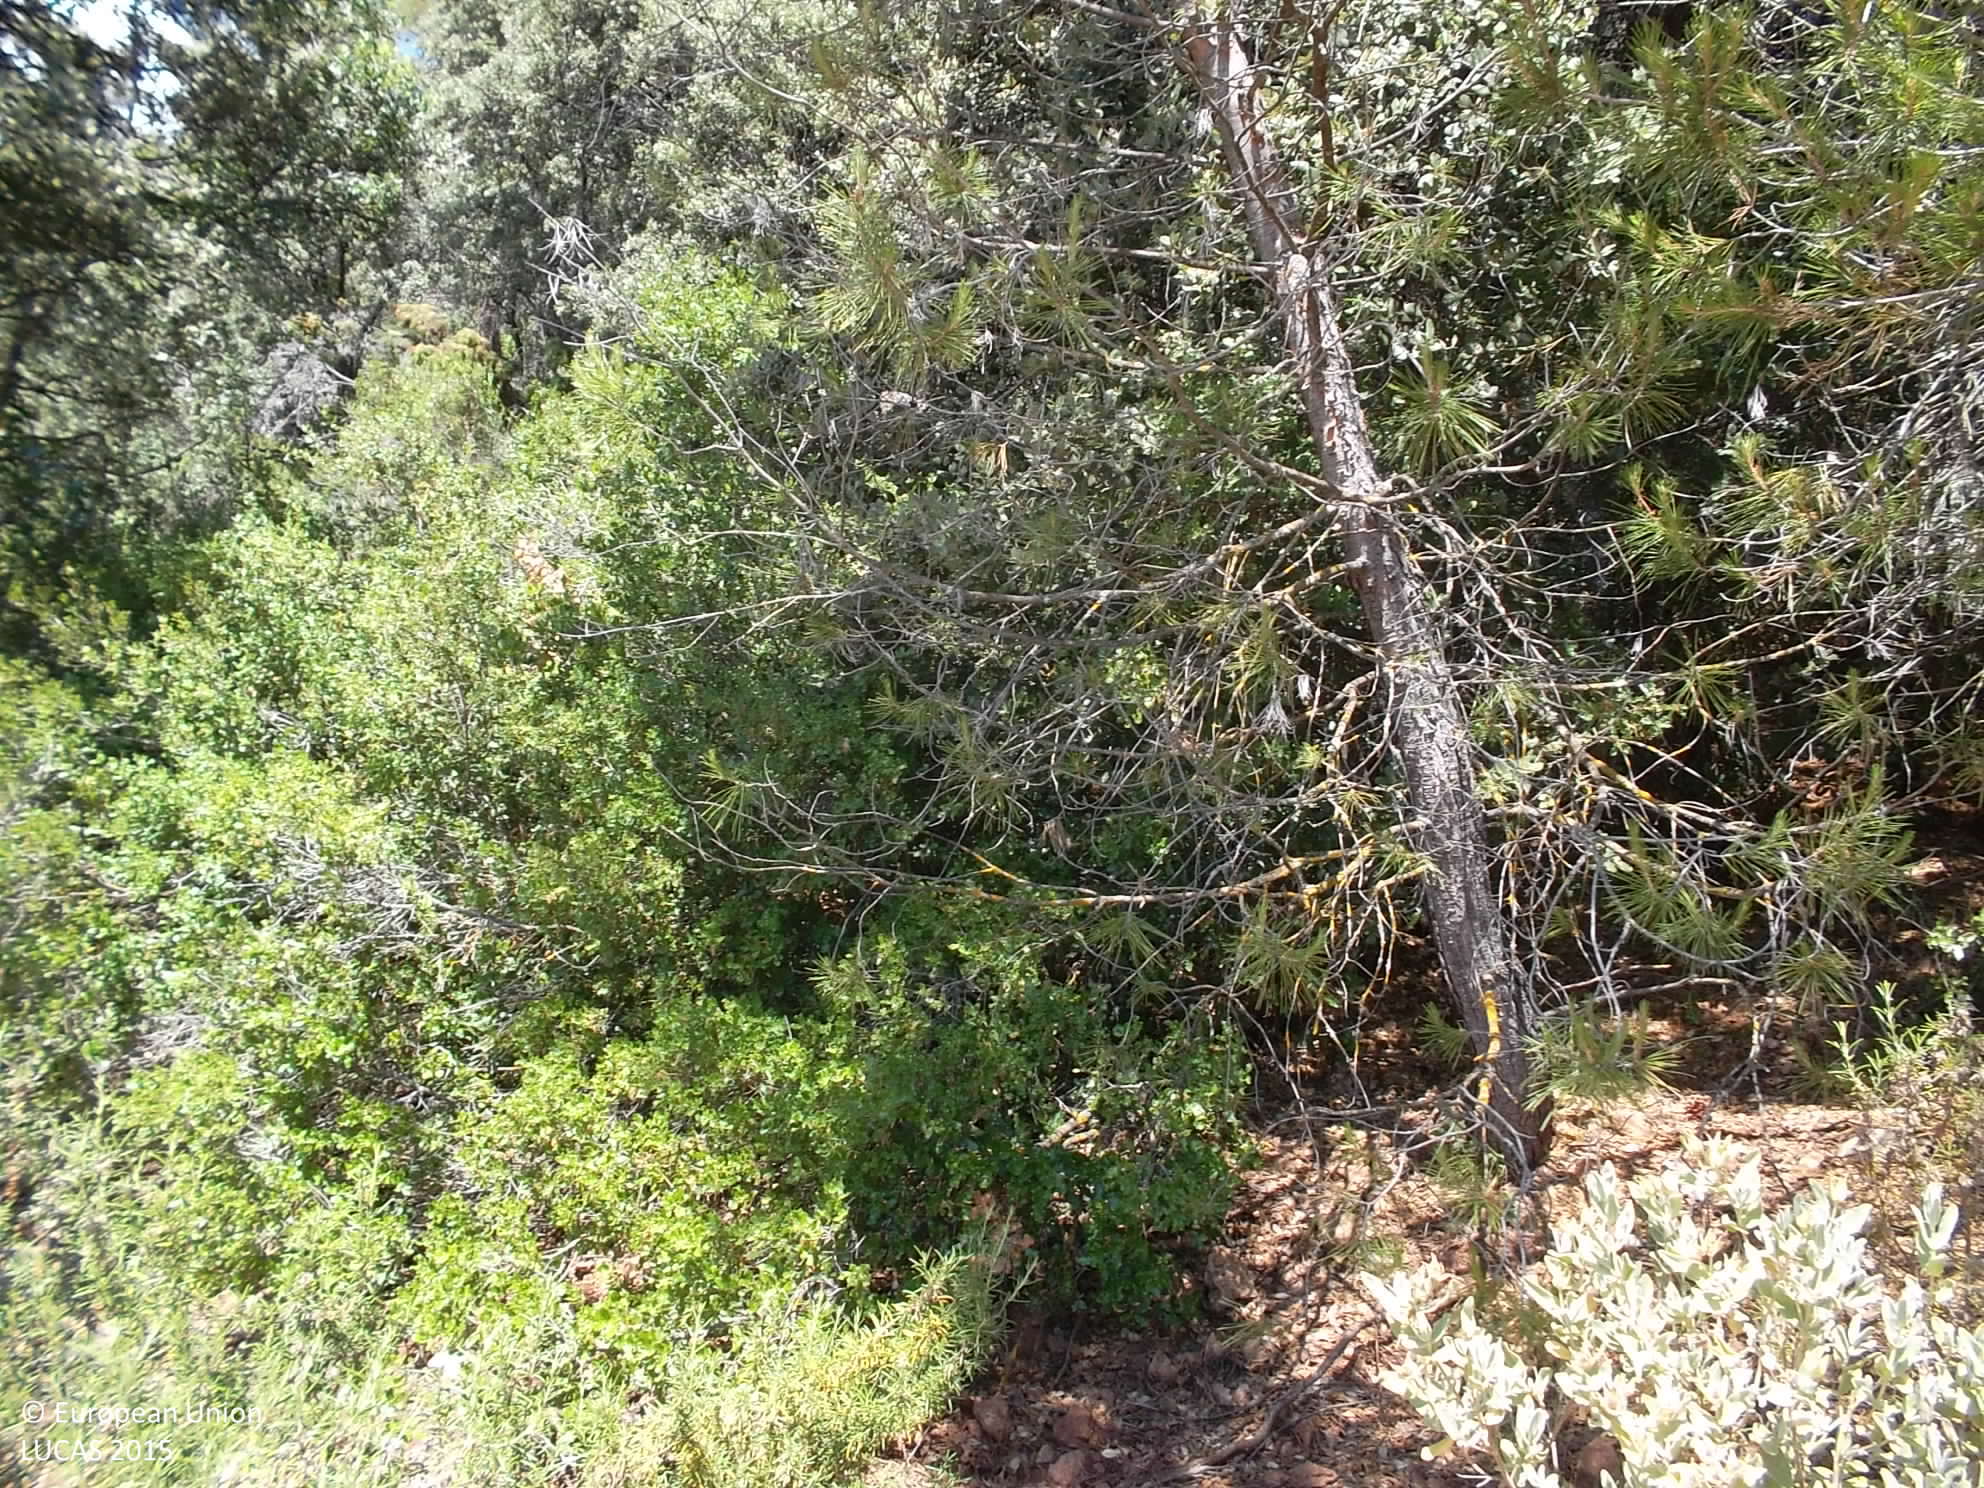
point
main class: Woodland
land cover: Pine dominated mixed woodland
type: alpine coniferous forest
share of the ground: 50 - 75 %
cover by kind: coniferous forest trees 45 %, shrubs 30 %, broadleaved forest trees 25 %
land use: Forestry
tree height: > 5 m
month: June
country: ES
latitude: 38.0432
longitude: -2.9983
